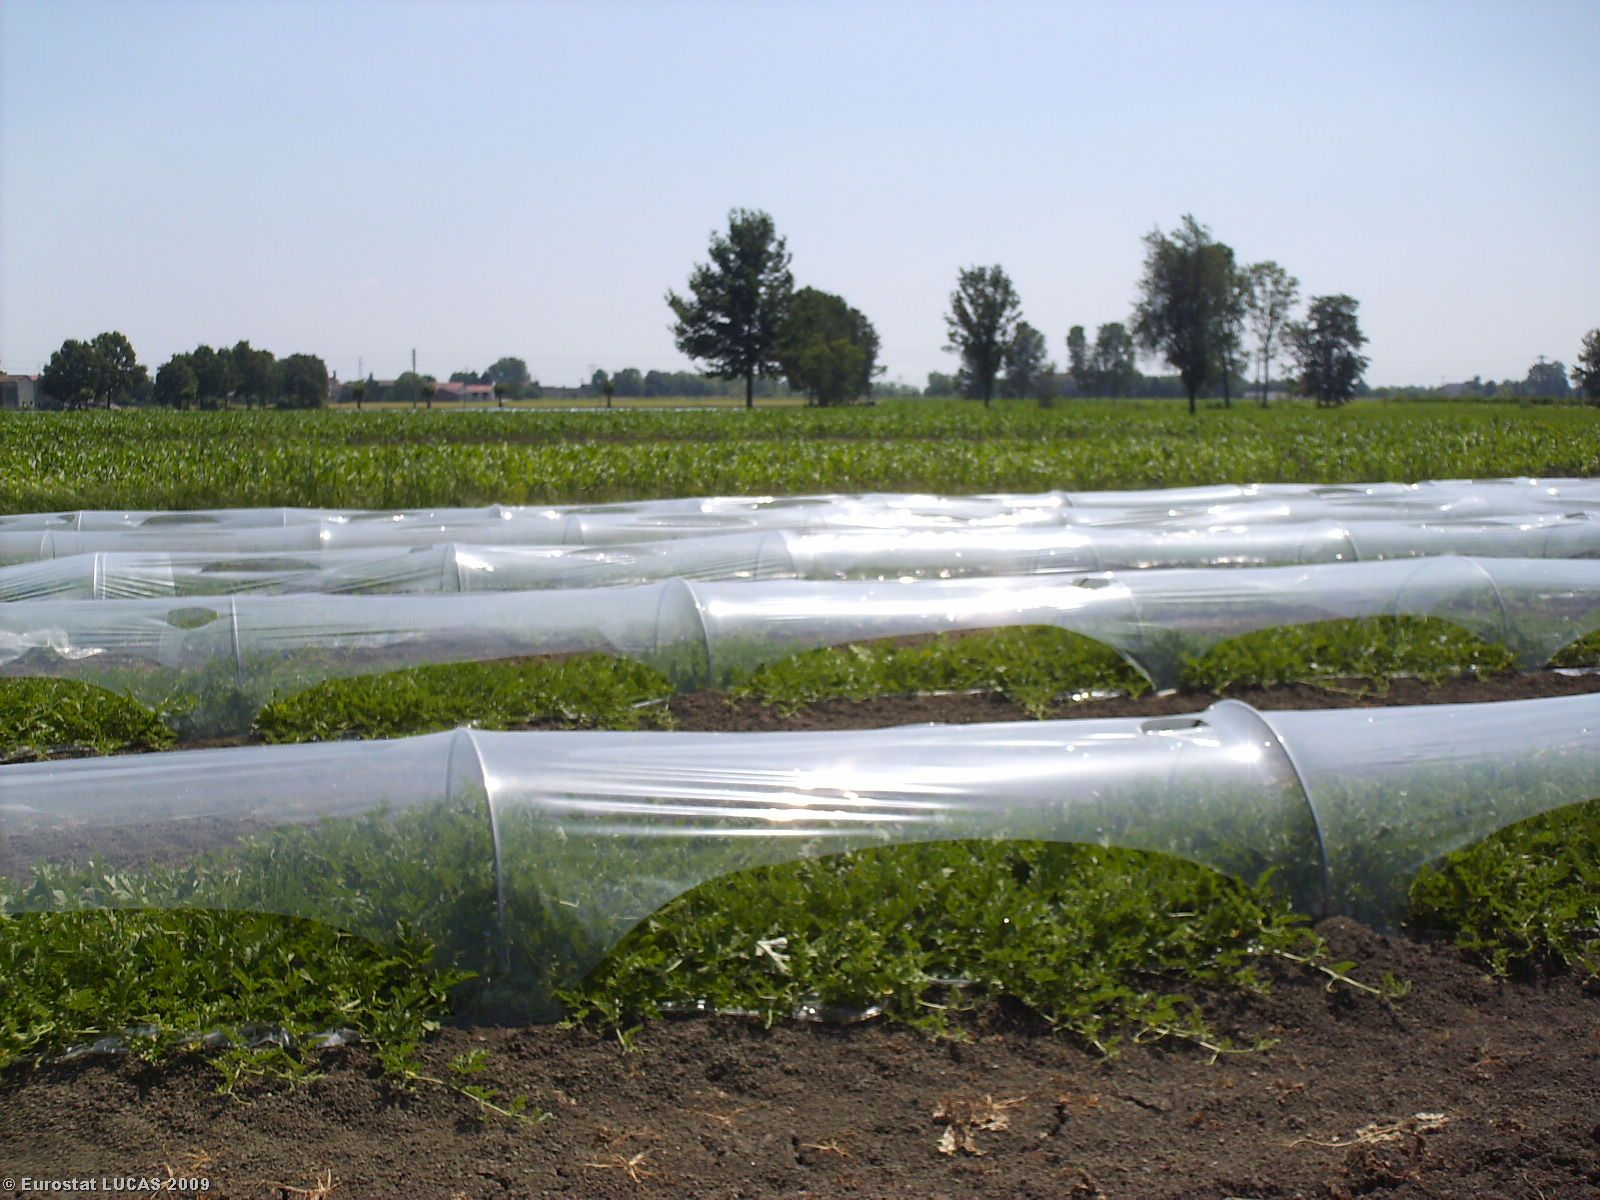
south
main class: Cropland
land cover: Other fresh vegetables
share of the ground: 25 - 50 %
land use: Agriculture (excluding fallow land and kitchen gardens)
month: June
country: IT
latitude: 45.0342
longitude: 10.5701
